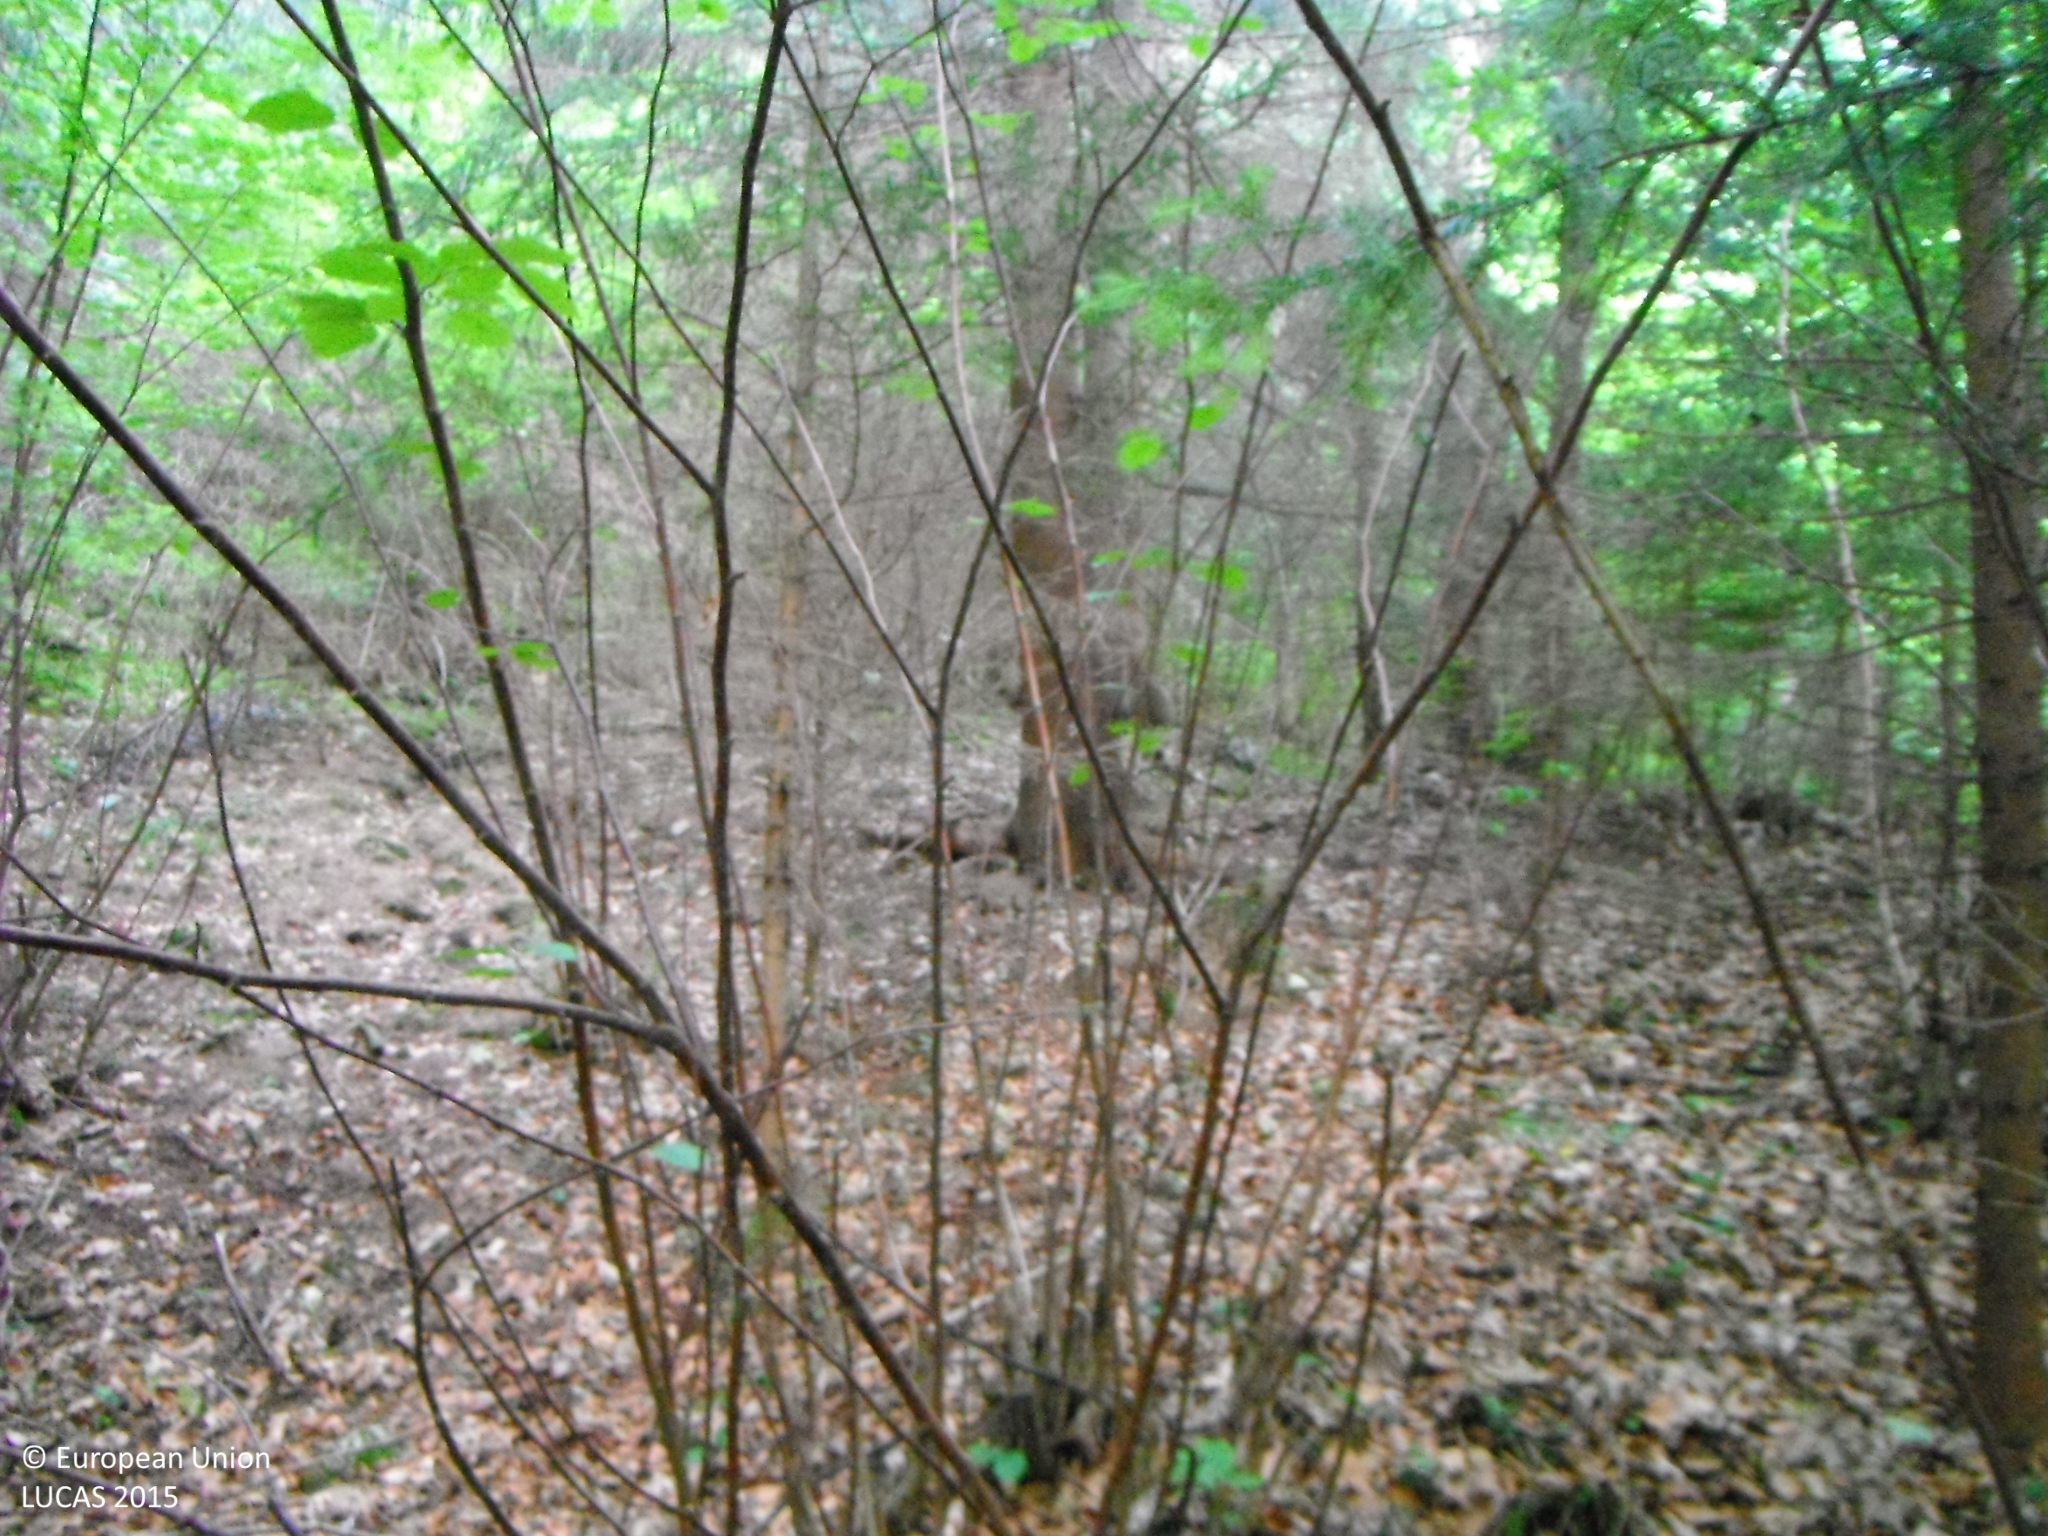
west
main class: Woodland
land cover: Spruce dominated mixed woodland
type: alpine coniferous forest
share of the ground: > 75 %
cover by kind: coniferous forest trees 70 %, broadleaved forest trees 30 %
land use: Forestry
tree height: > 5 m
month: June
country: SK
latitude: 49.1534
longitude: 19.2792
